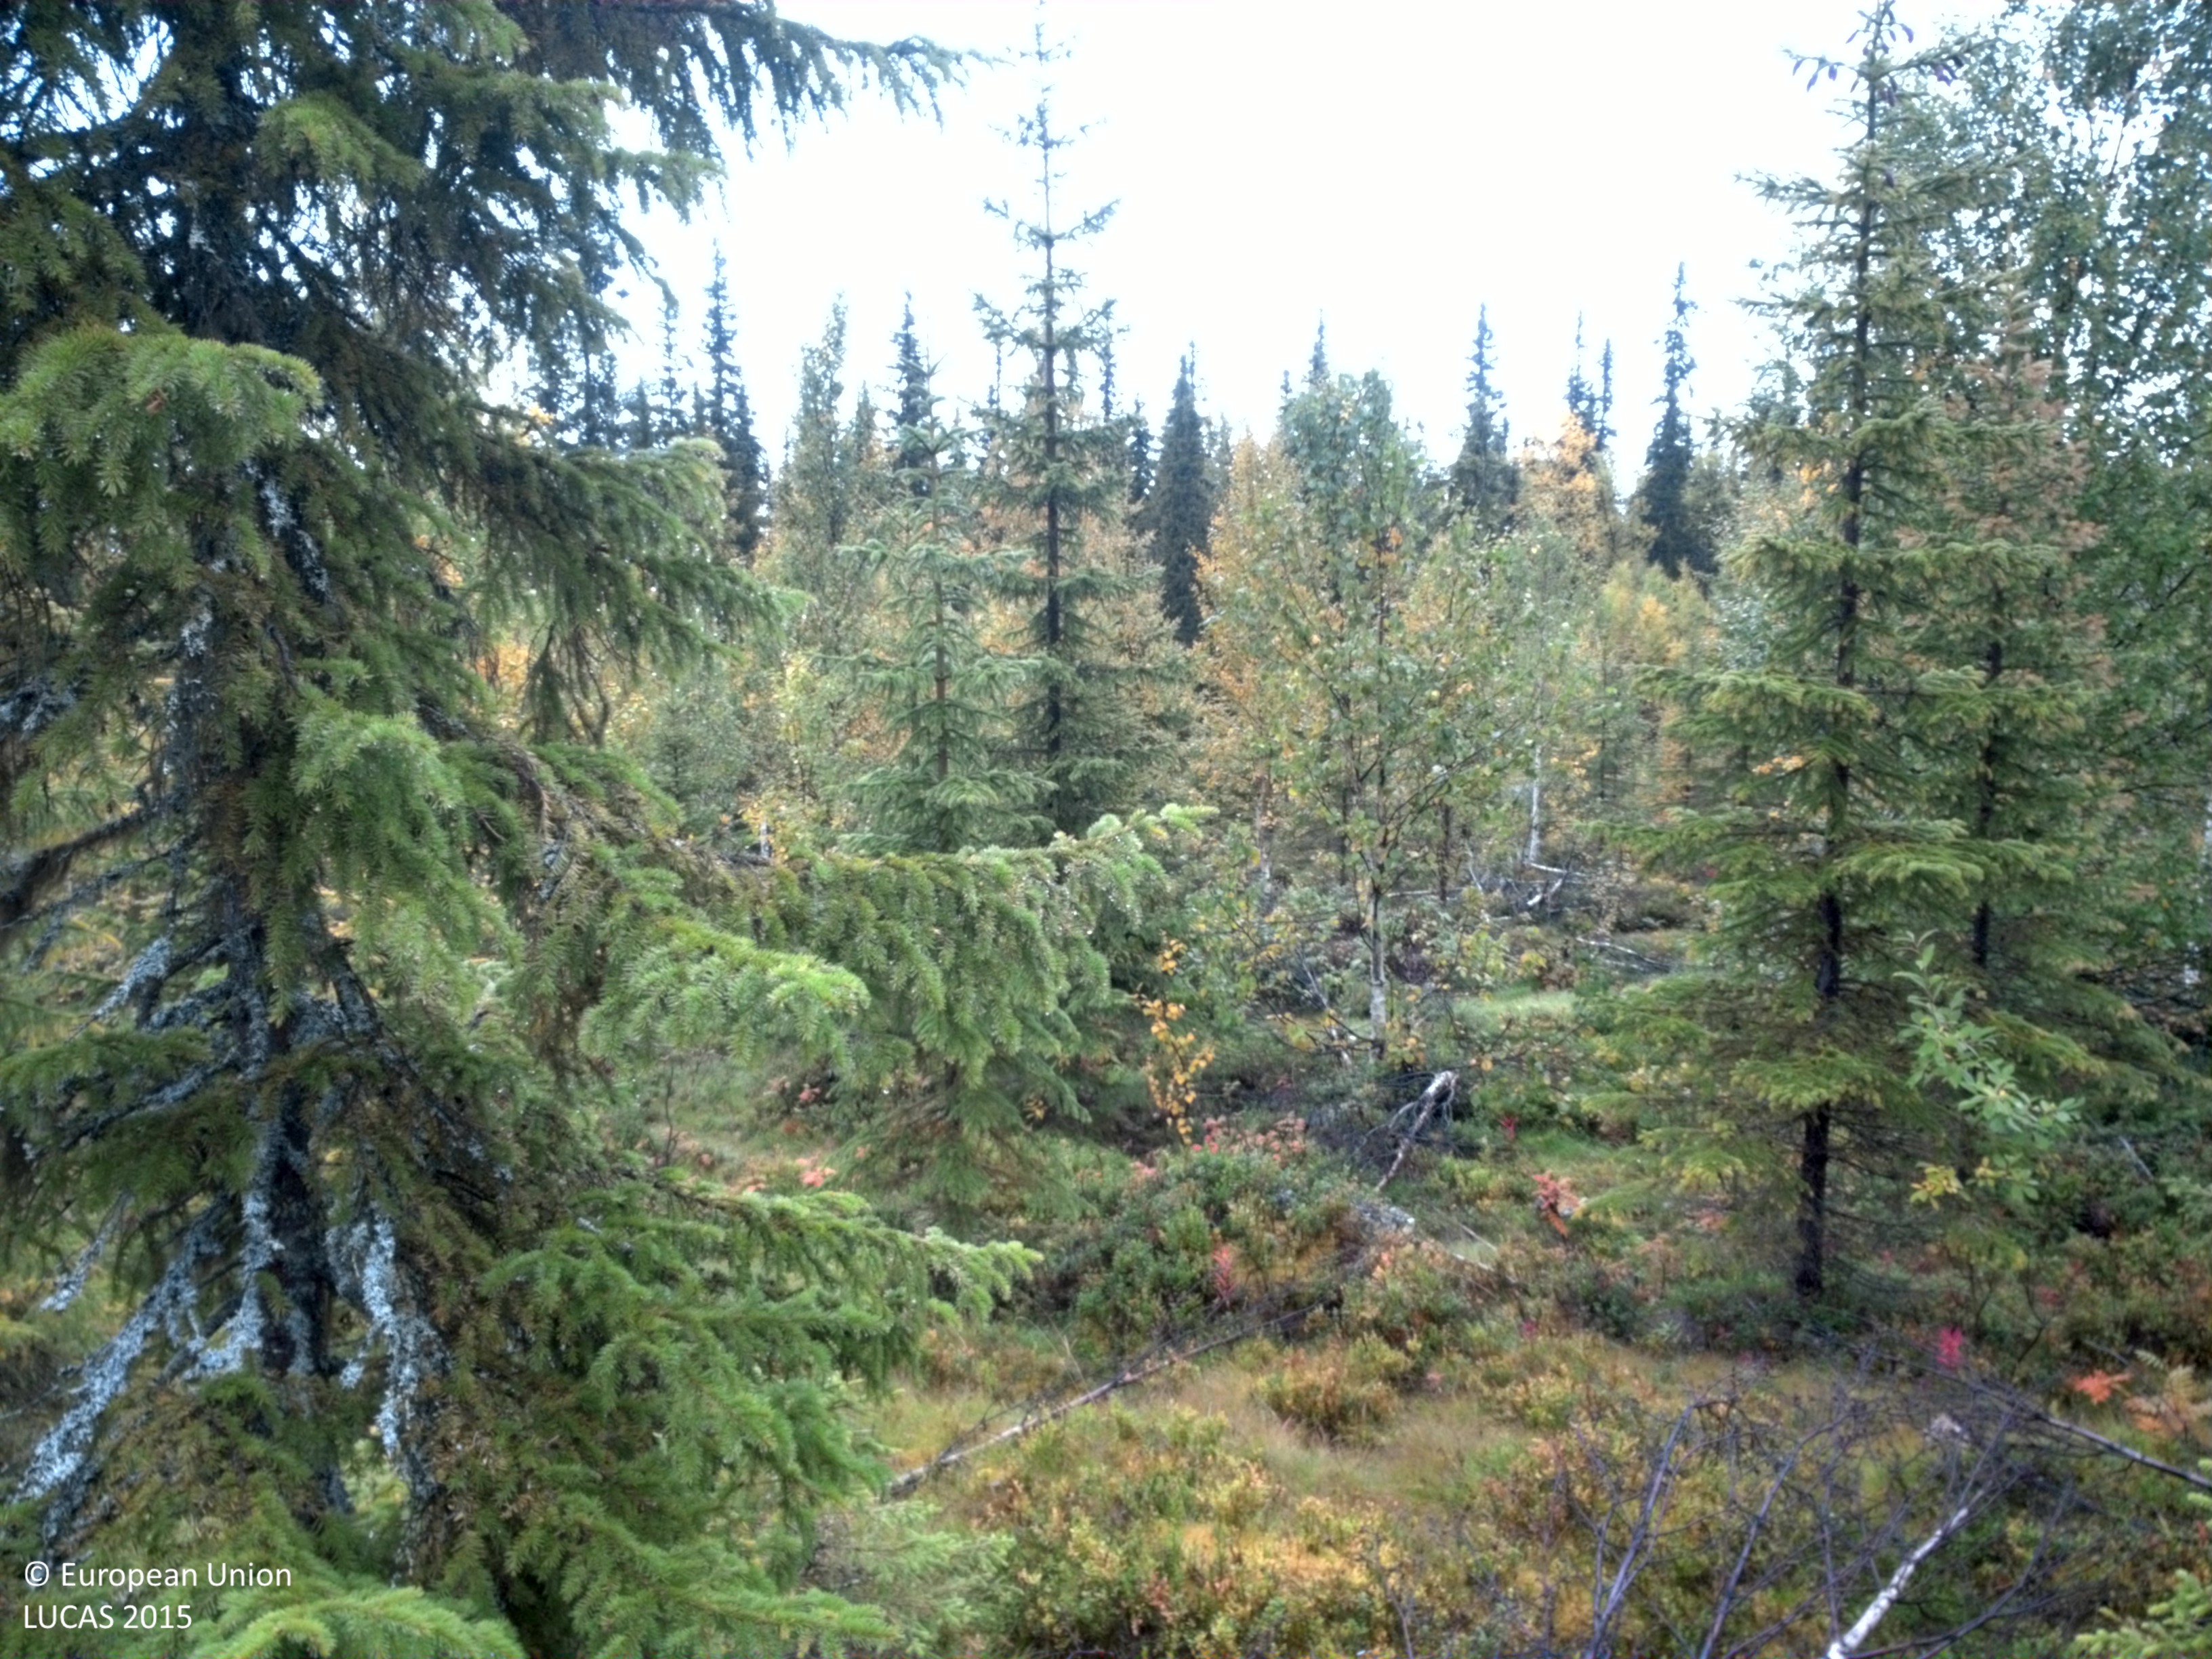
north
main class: Woodland
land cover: Spruce dominated mixed woodland
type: boreal forest
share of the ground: 10 - 25 %
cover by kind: shrubs 50 %, lichens and mosses 20 %, herbaceous plants 15 %, coniferous forest trees 10 %, broadleaved forest trees 5 %
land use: Forestry
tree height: > 5 m
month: September
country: SE
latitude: 65.1838
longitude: 16.6468
